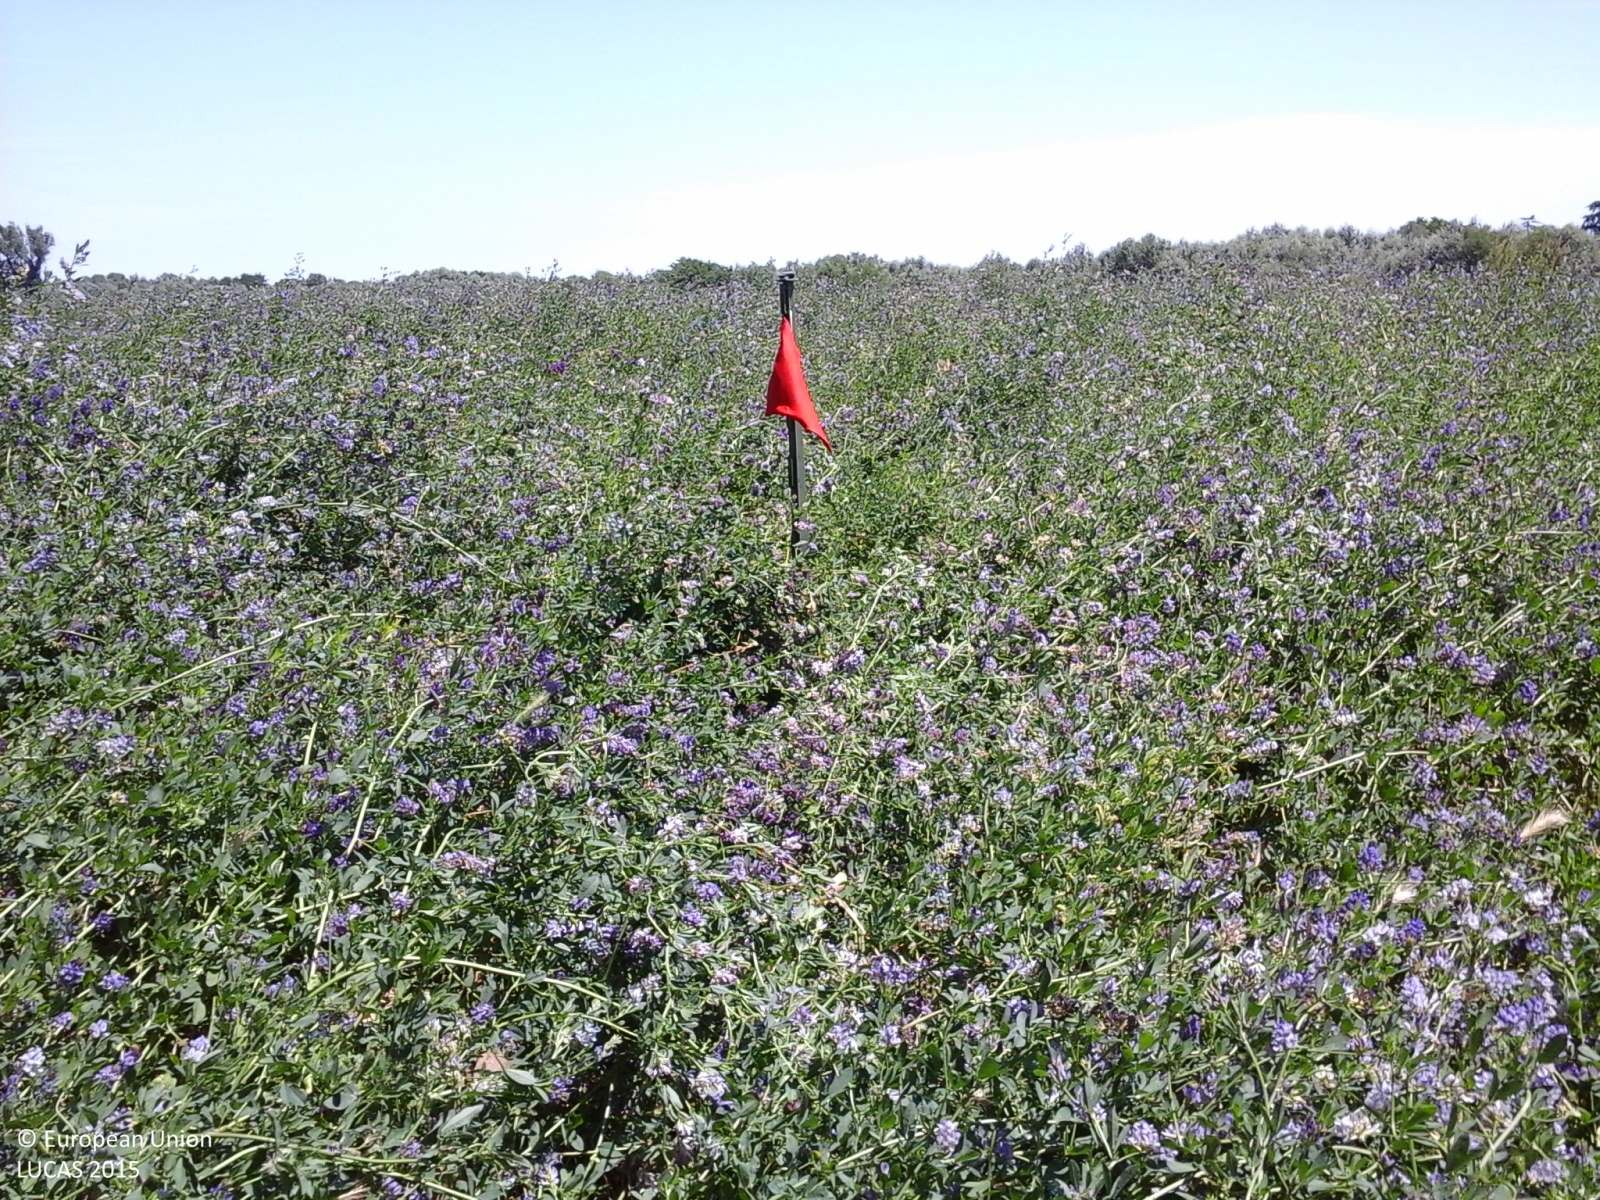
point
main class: Cropland
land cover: Lucerne
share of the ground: > 75 %
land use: Agriculture (excluding fallow land and kitchen gardens)
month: June
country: IT
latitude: 44.2363
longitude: 12.2362
